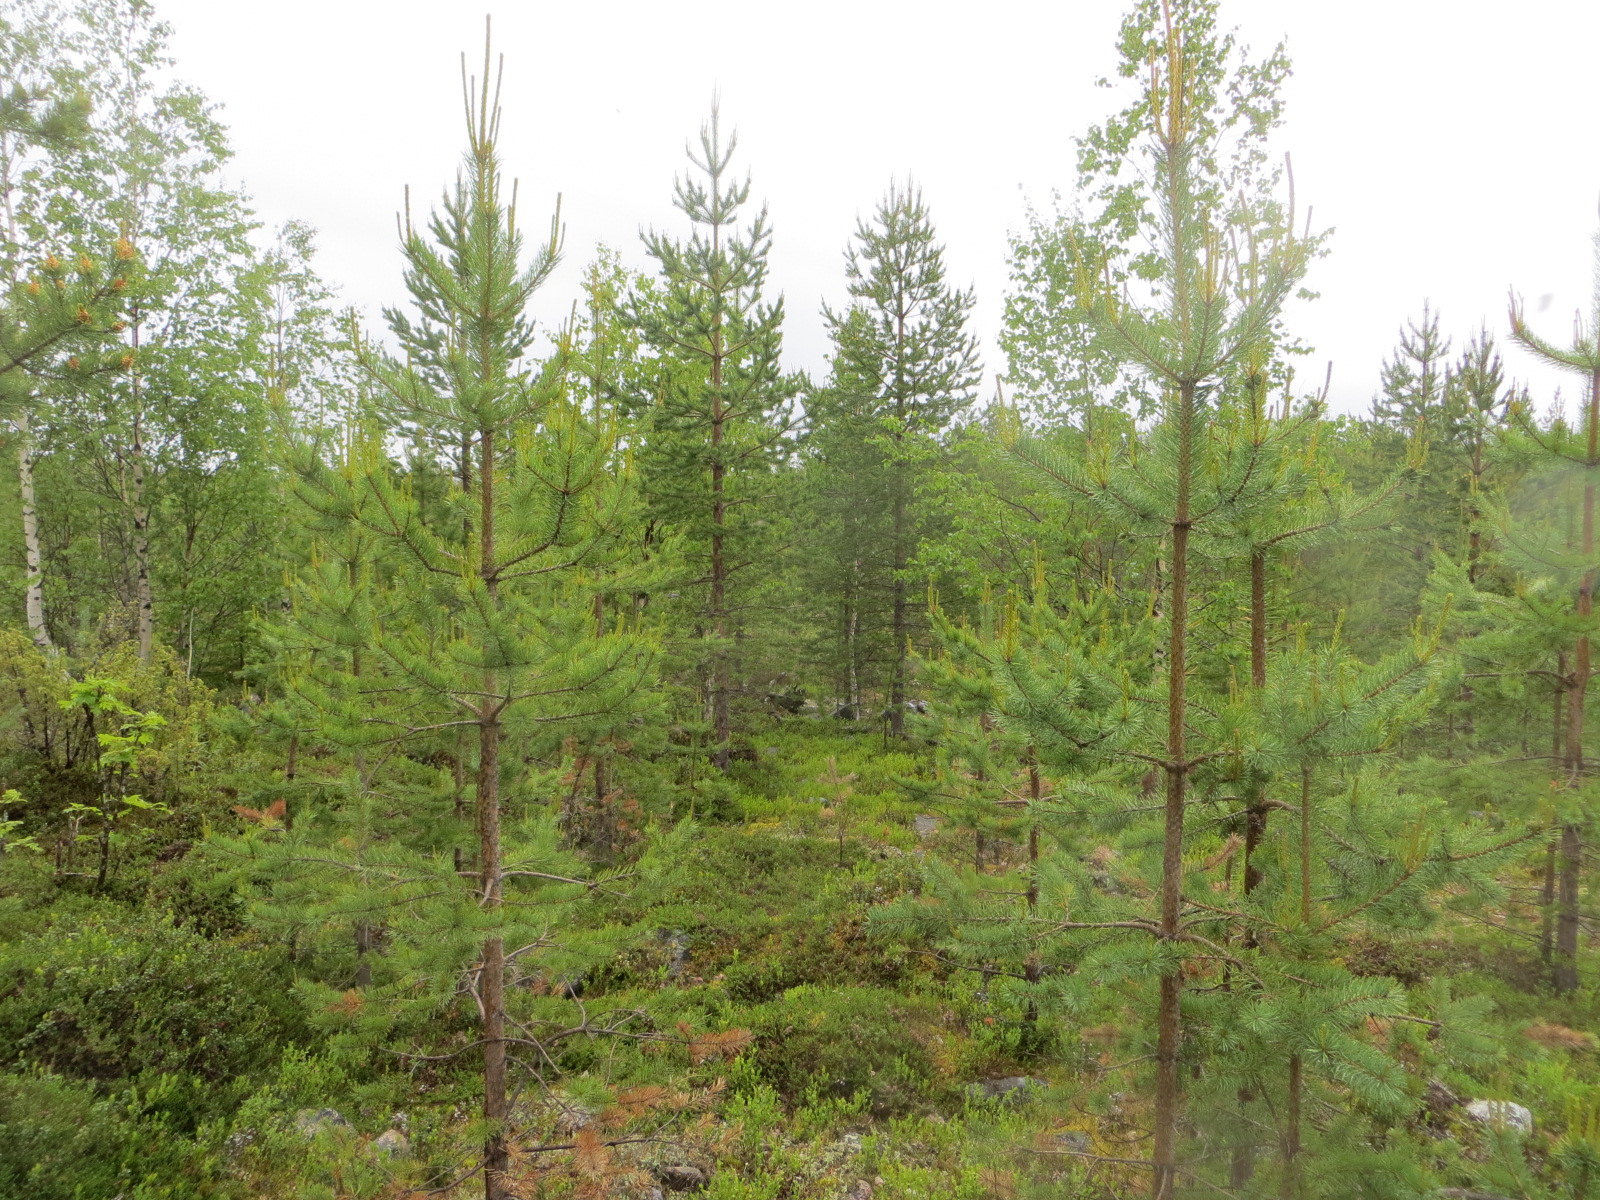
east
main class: Woodland
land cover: Pine dominated mixed woodland
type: boreal forest
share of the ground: 50 - 75 %
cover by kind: coniferous forest trees 45 %, broadleaved forest trees 25 %, shrubs 20 %, lichens and mosses 10 %
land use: Forestry
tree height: < 5 m
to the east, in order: Pine dominated mixed woodland; Pine dominated coniferous woodland
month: June
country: FI
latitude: 66.0249
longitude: 26.9332
